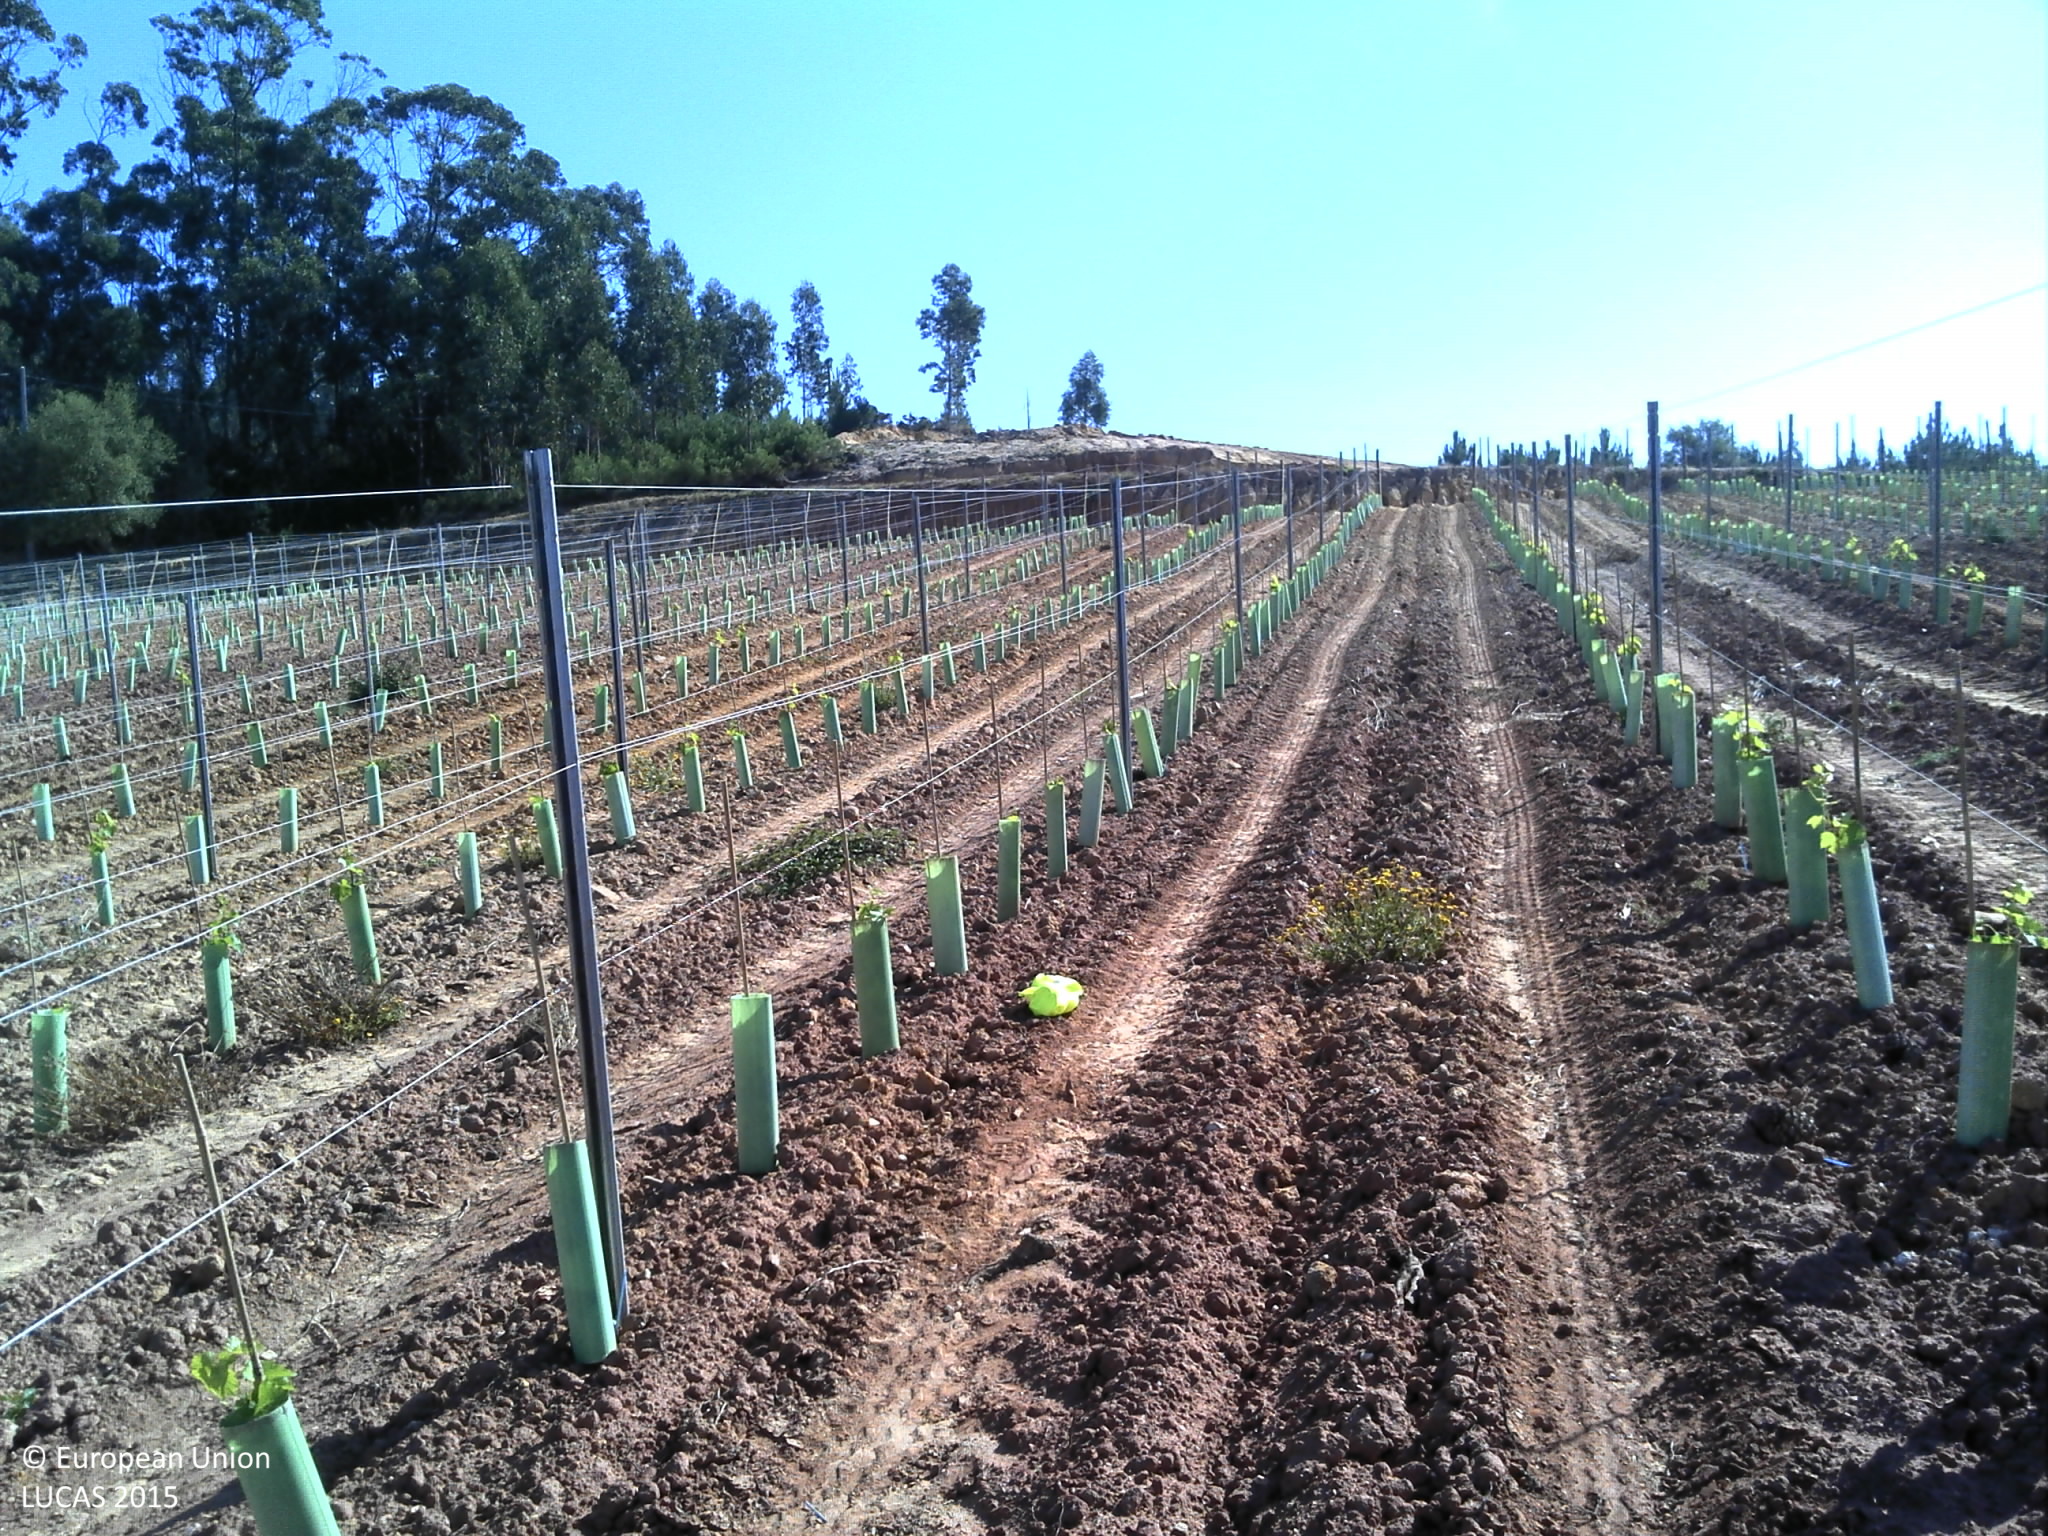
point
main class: Cropland
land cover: Vineyards
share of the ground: < 10 %
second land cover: Other bare soil
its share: > 75 %
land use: Agriculture (excluding fallow land and kitchen gardens)
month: June
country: PT
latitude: 39.1059
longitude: -9.2238
